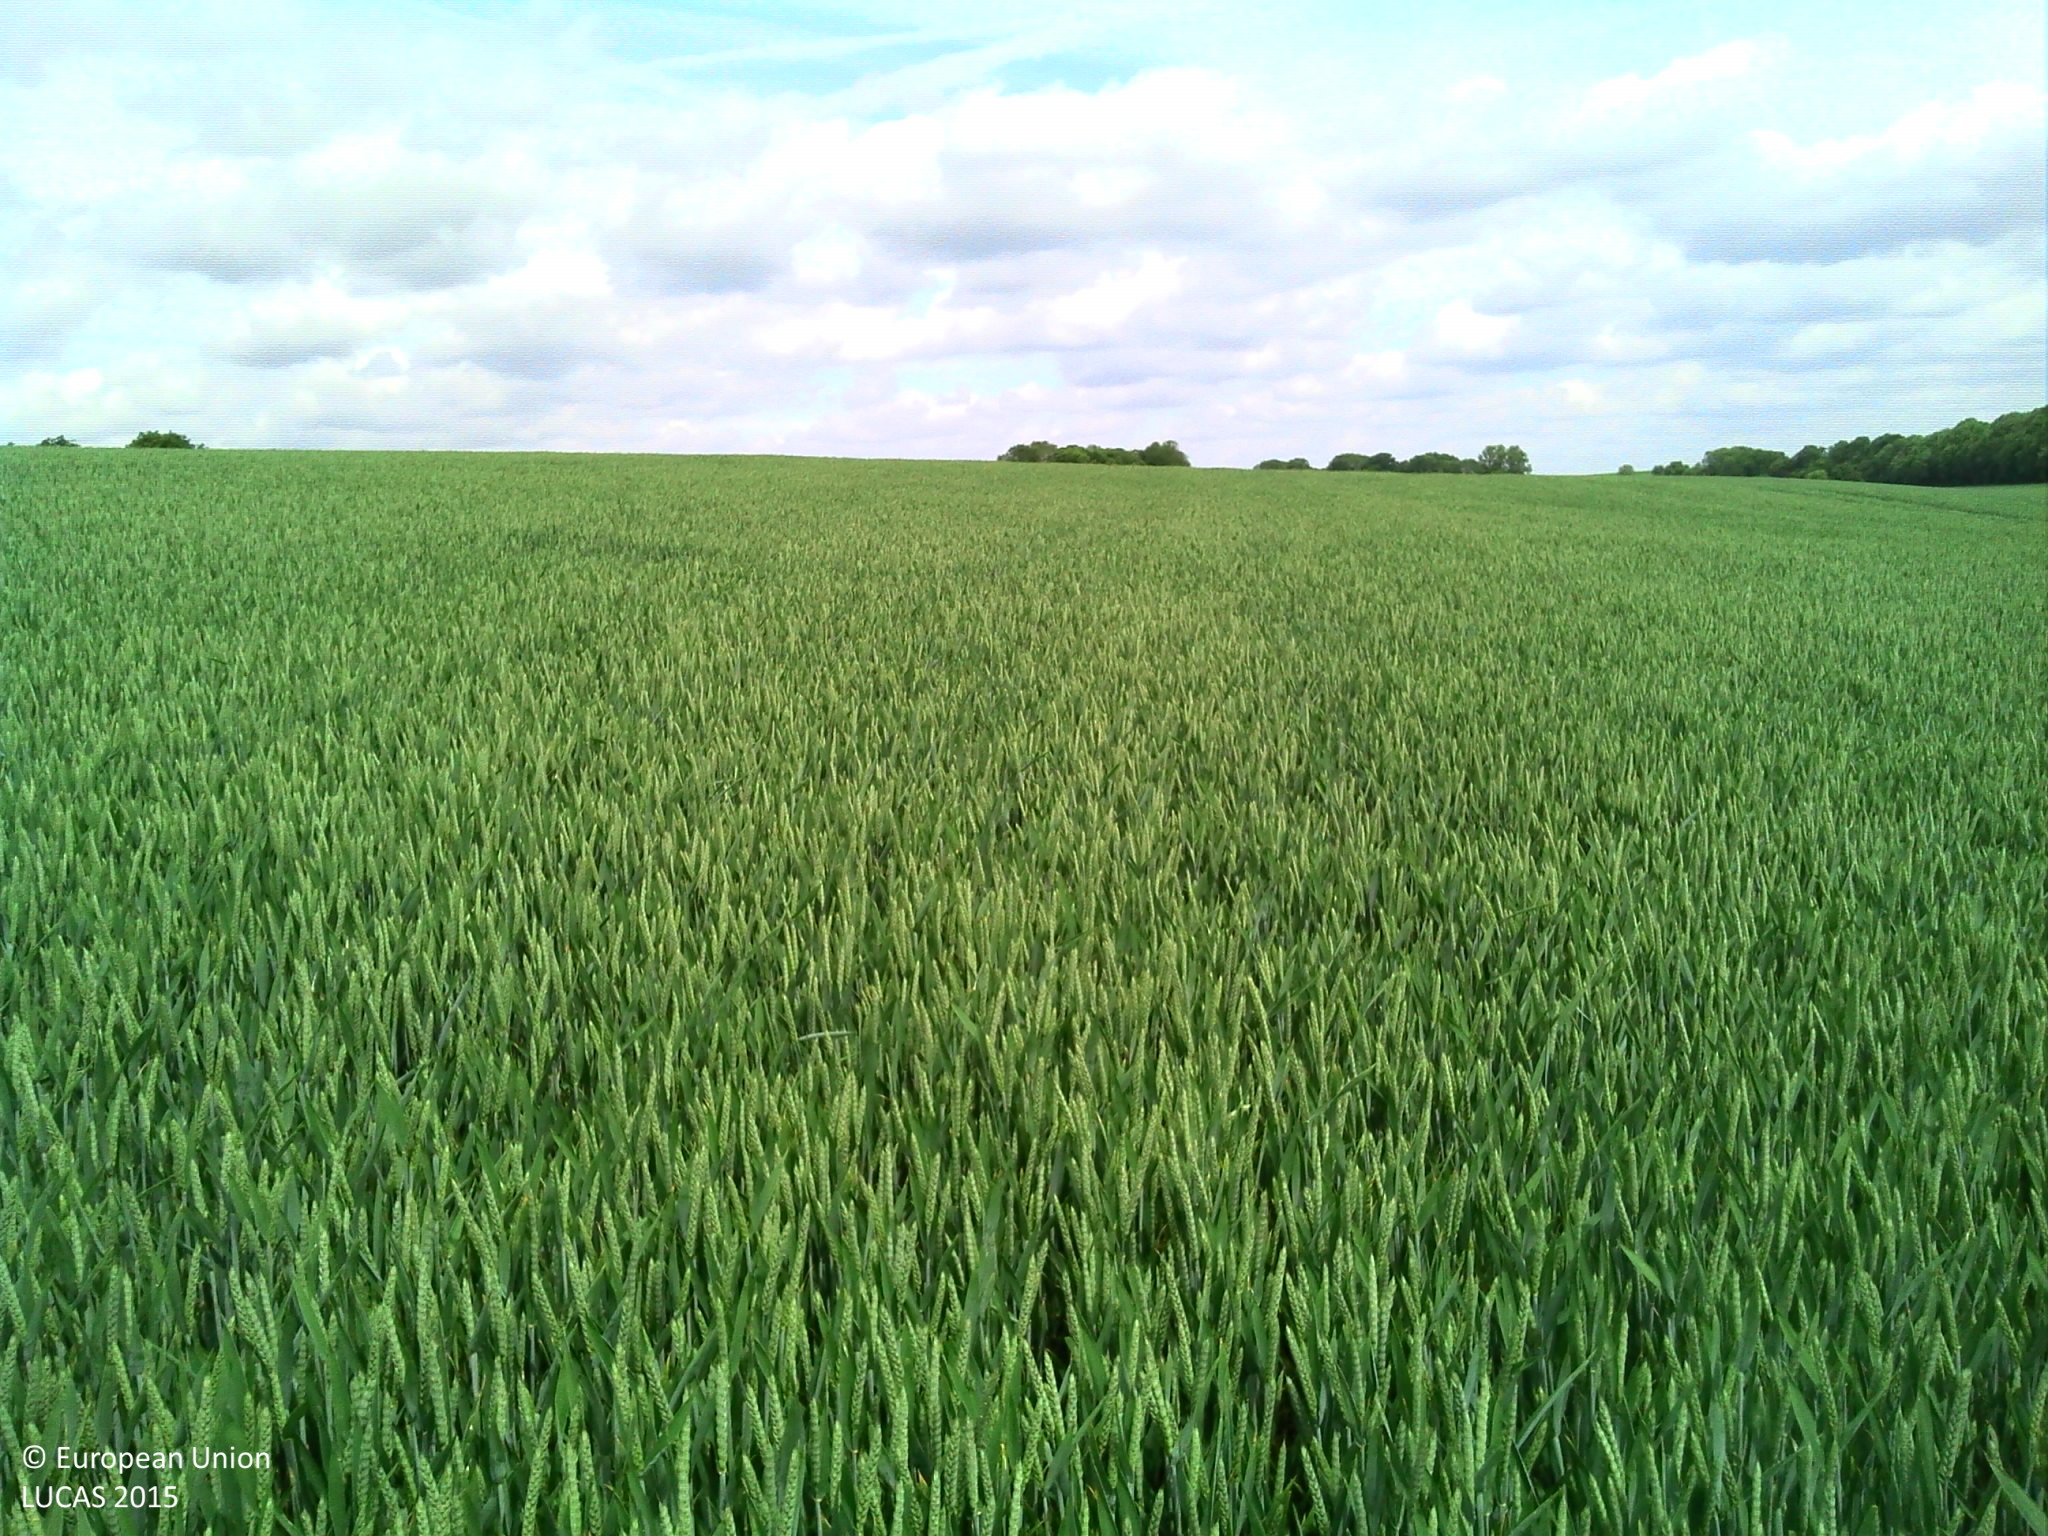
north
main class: Cropland
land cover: Common wheat
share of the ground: > 75 %
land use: Agriculture (excluding fallow land and kitchen gardens)
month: May
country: FR
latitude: 49.8005
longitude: 3.1973
